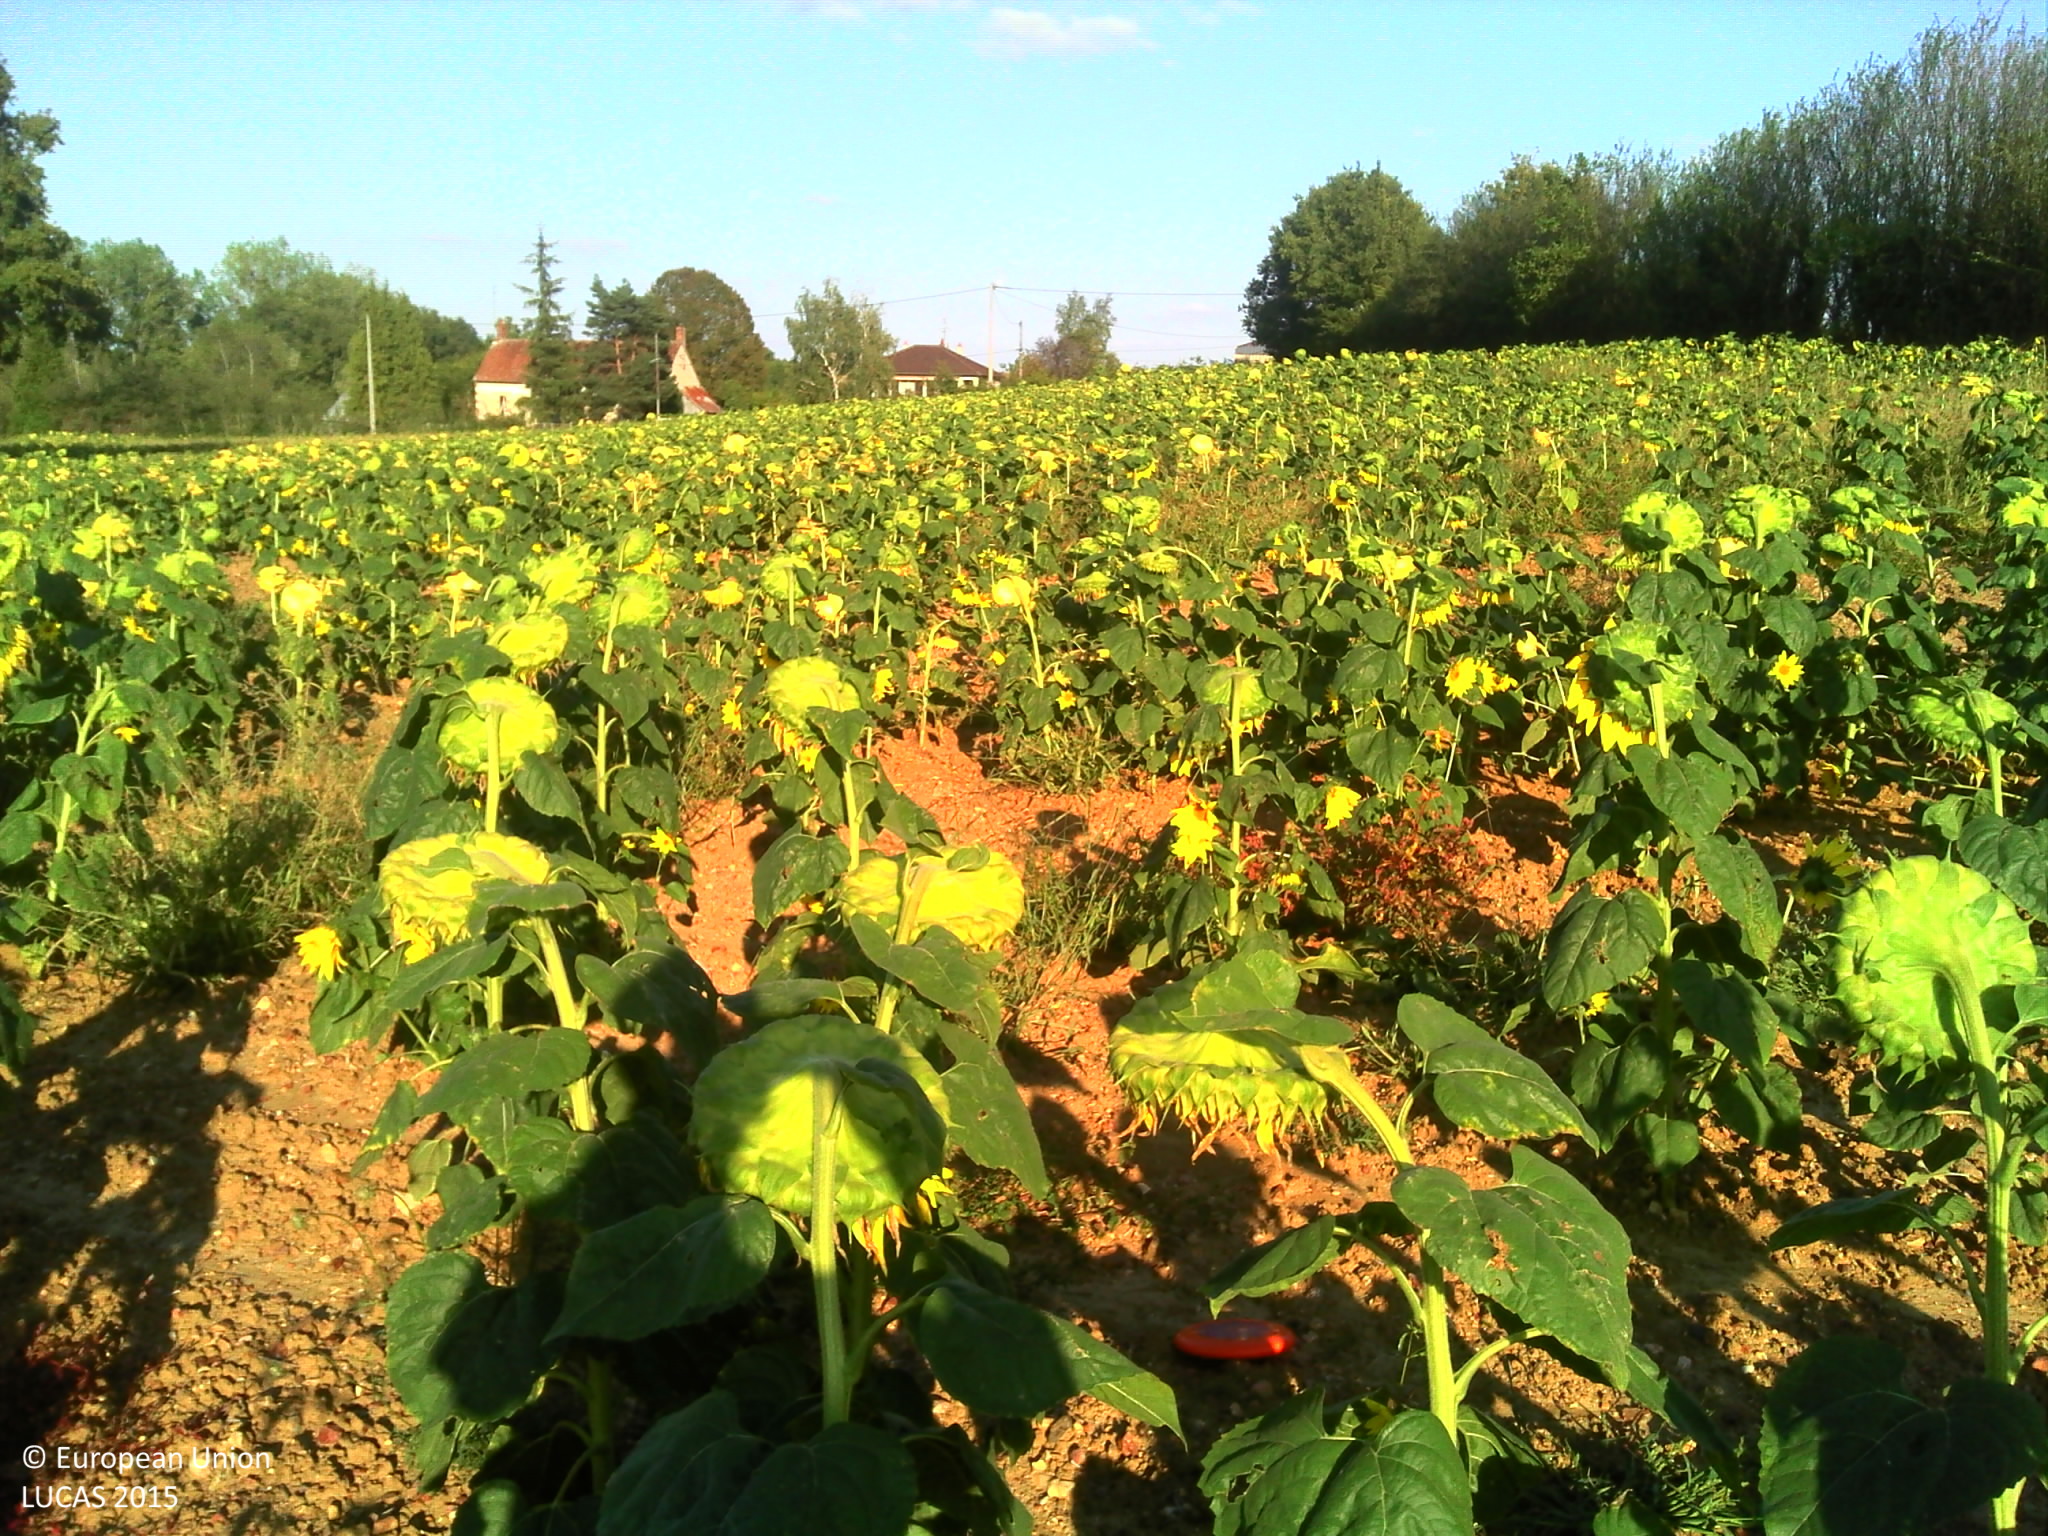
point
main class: Cropland
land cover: Sunflower
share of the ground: > 75 %
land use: Agriculture (excluding fallow land and kitchen gardens)
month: September
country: FR
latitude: 47.0442
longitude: 1.4982
